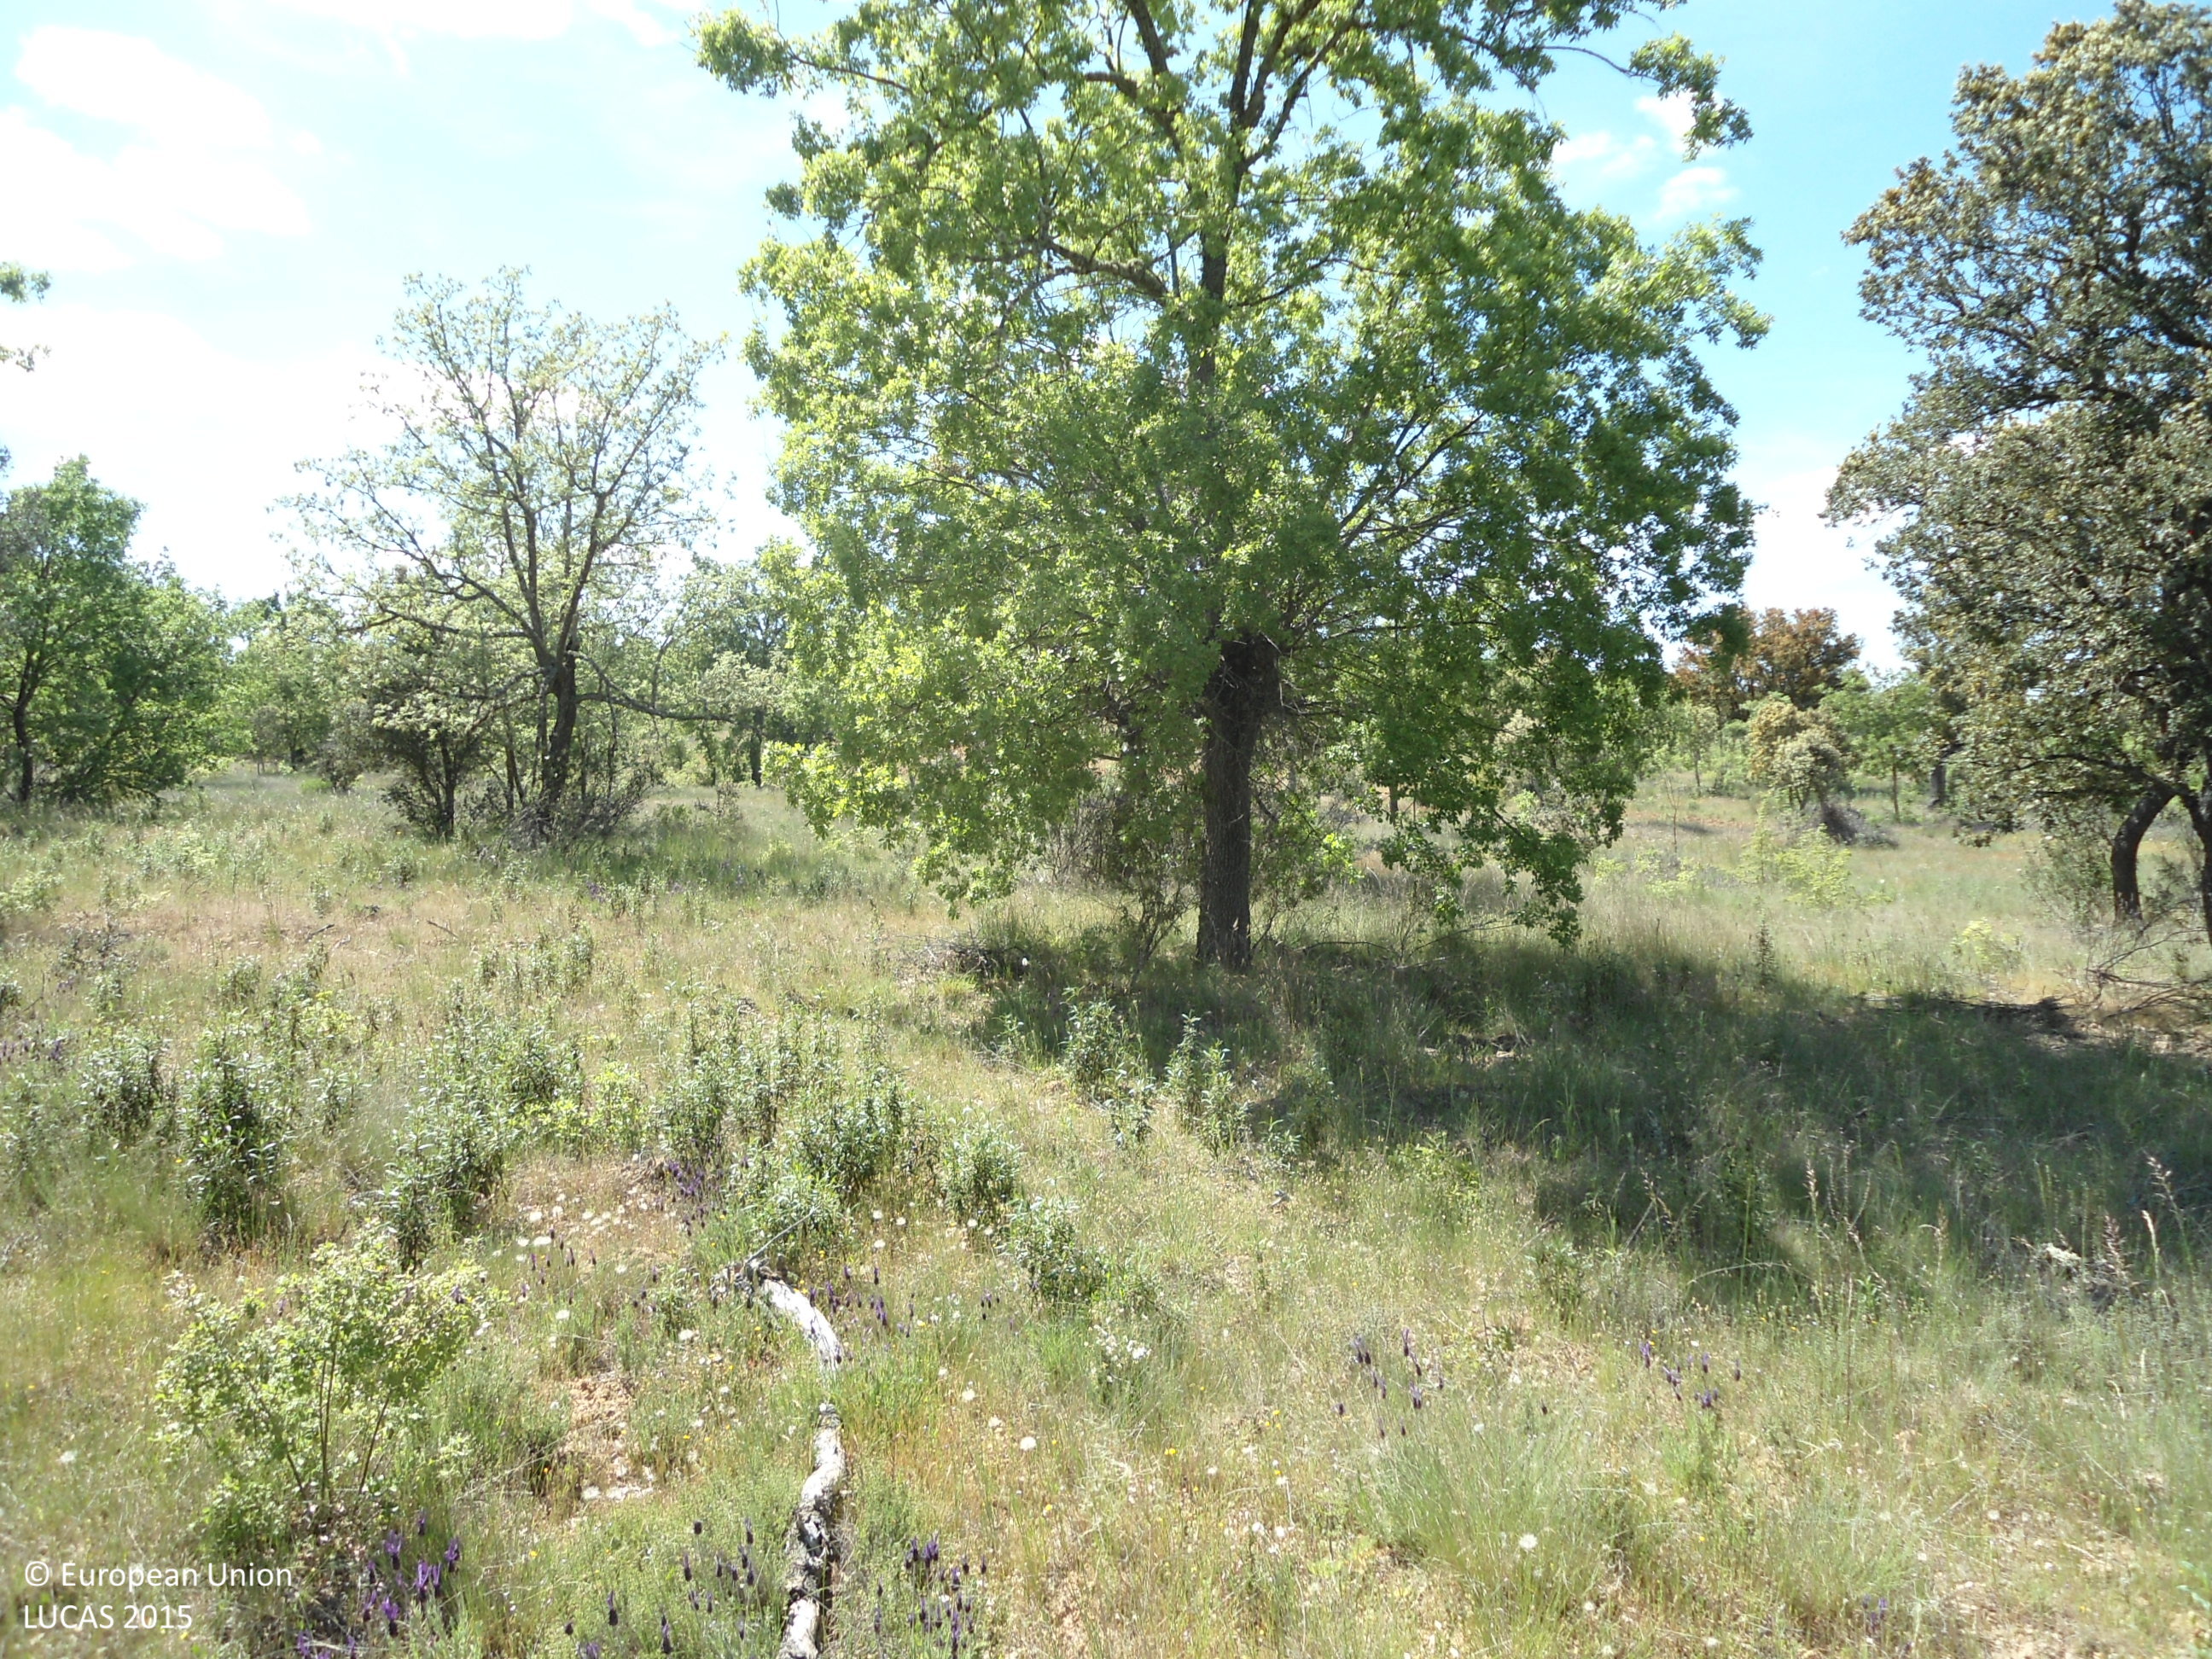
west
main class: Woodland
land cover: Broadleaved woodland
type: acidophilous oak and oak-birch forest
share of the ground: > 75 %
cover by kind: broadleaved forest trees 80 %, shrubs 10 %, herbaceous plants 10 %
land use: Forestry
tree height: > 5 m
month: May
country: ES
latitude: 41.9095
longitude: -5.9742
